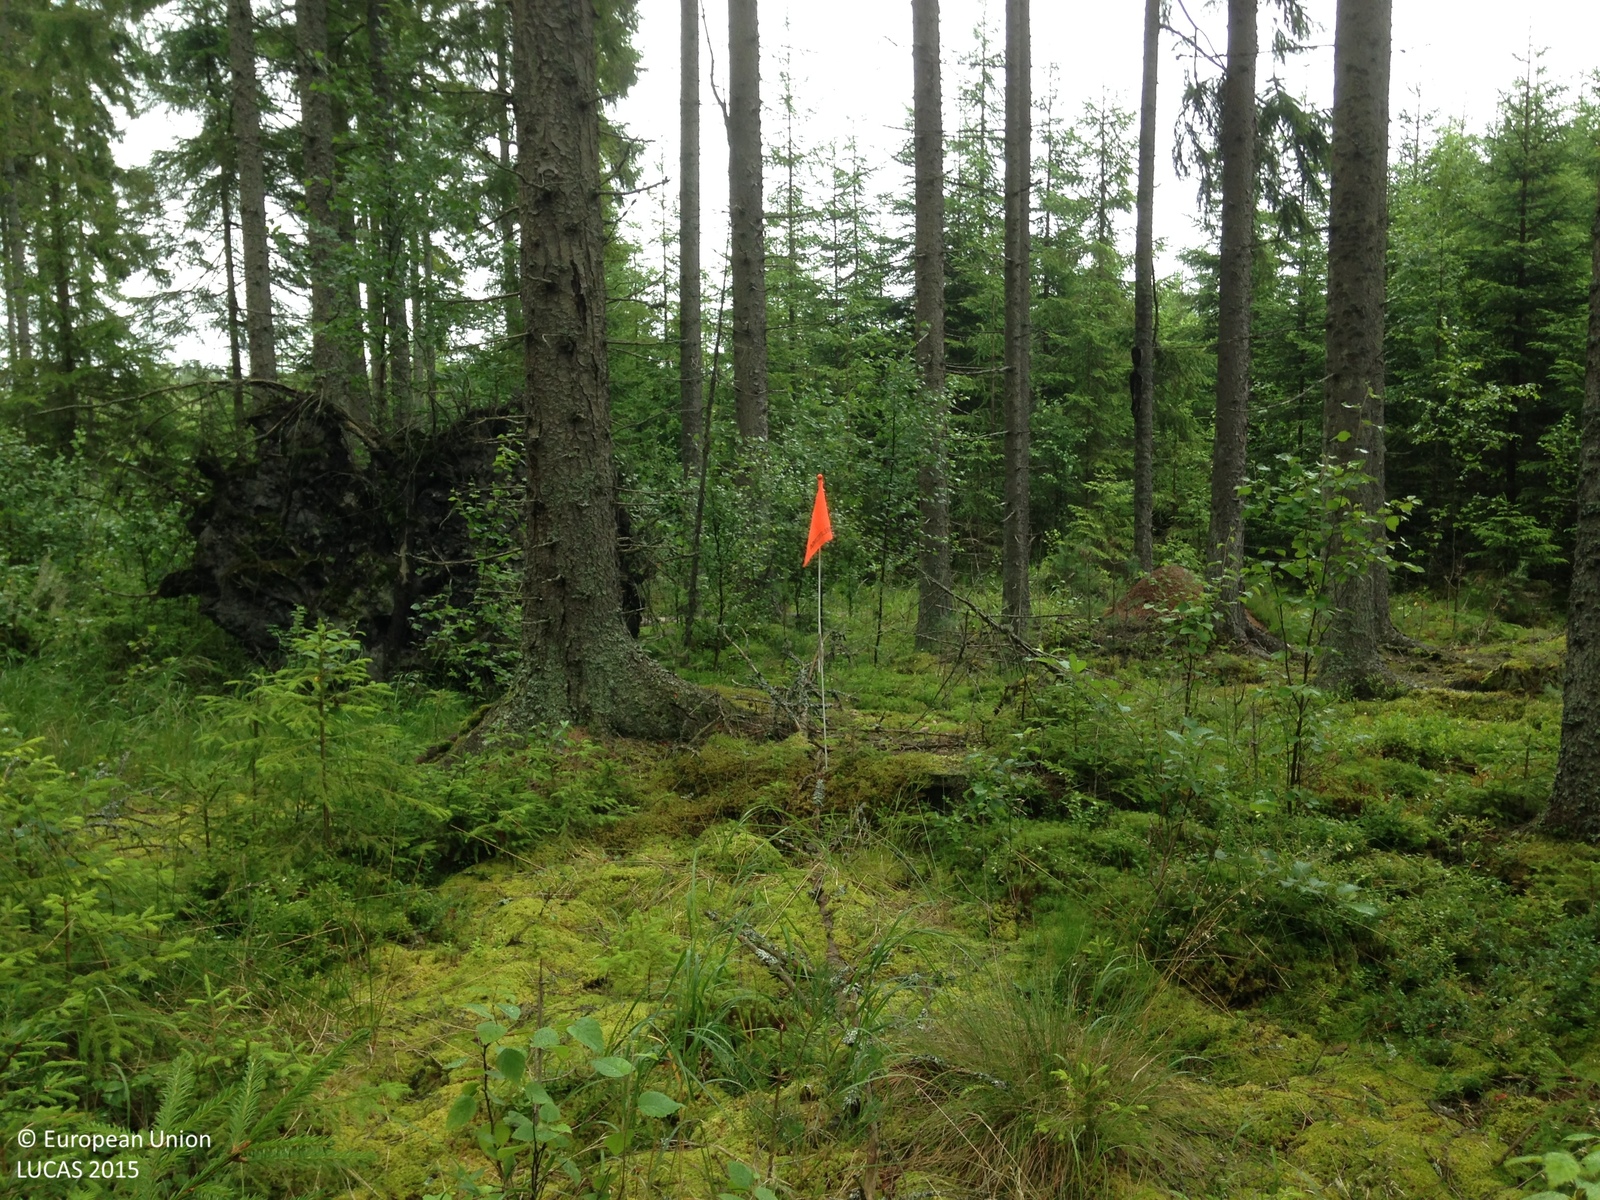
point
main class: Woodland
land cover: Spruce dominated coniferous woodland
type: boreal forest
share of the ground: 25 - 50 %
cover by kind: coniferous forest trees 35 %, herbaceous plants 30 %, lichens and mosses 20 %, shrubs 10 %, broadleaved forest trees 5 %
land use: Forestry
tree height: > 5 m
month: July
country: SE
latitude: 59.0809
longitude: 14.5112
